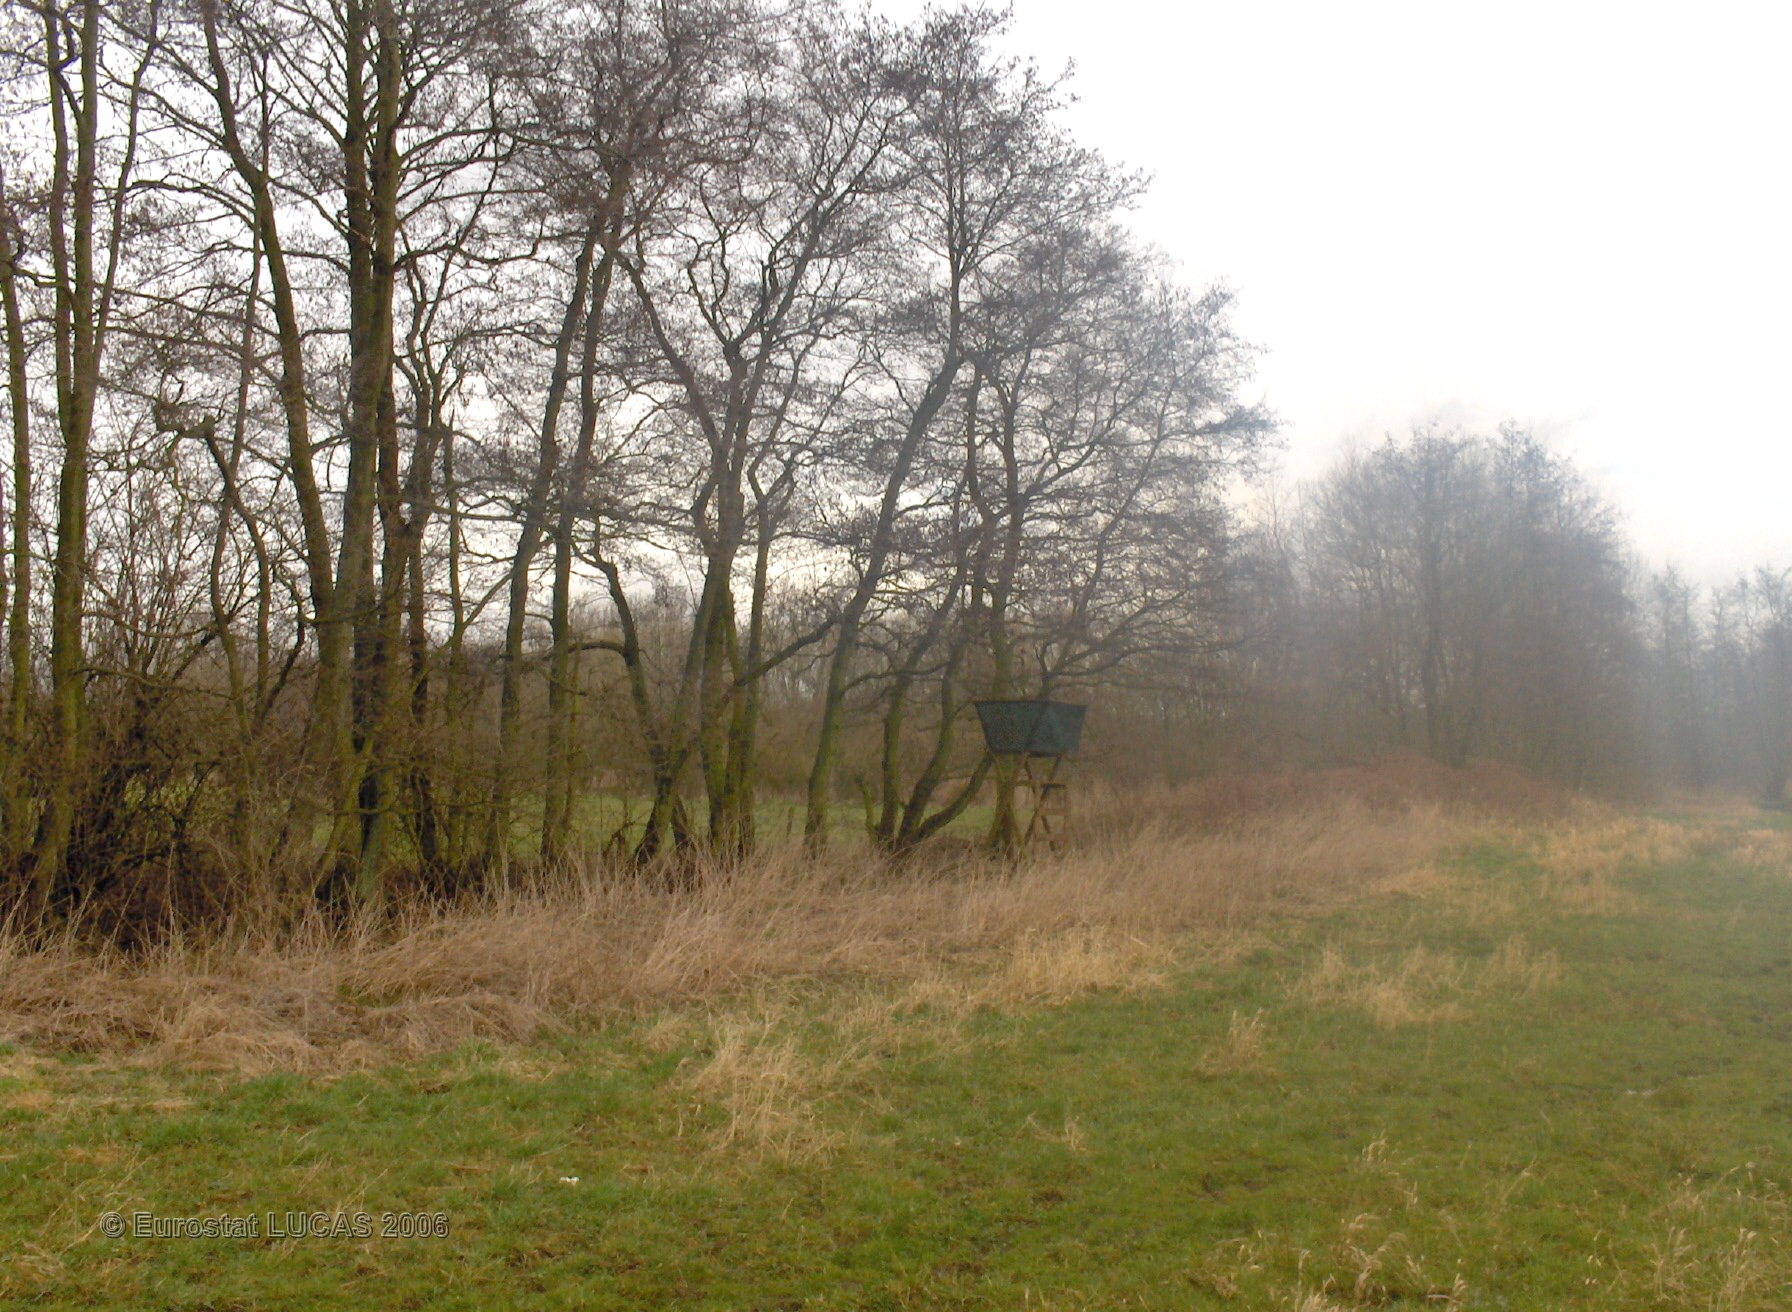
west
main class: Grassland
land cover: Grassland without tree/shrub cover
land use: Amenities, museums, leisure
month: March
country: BE
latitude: 51.1451
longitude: 5.1803
